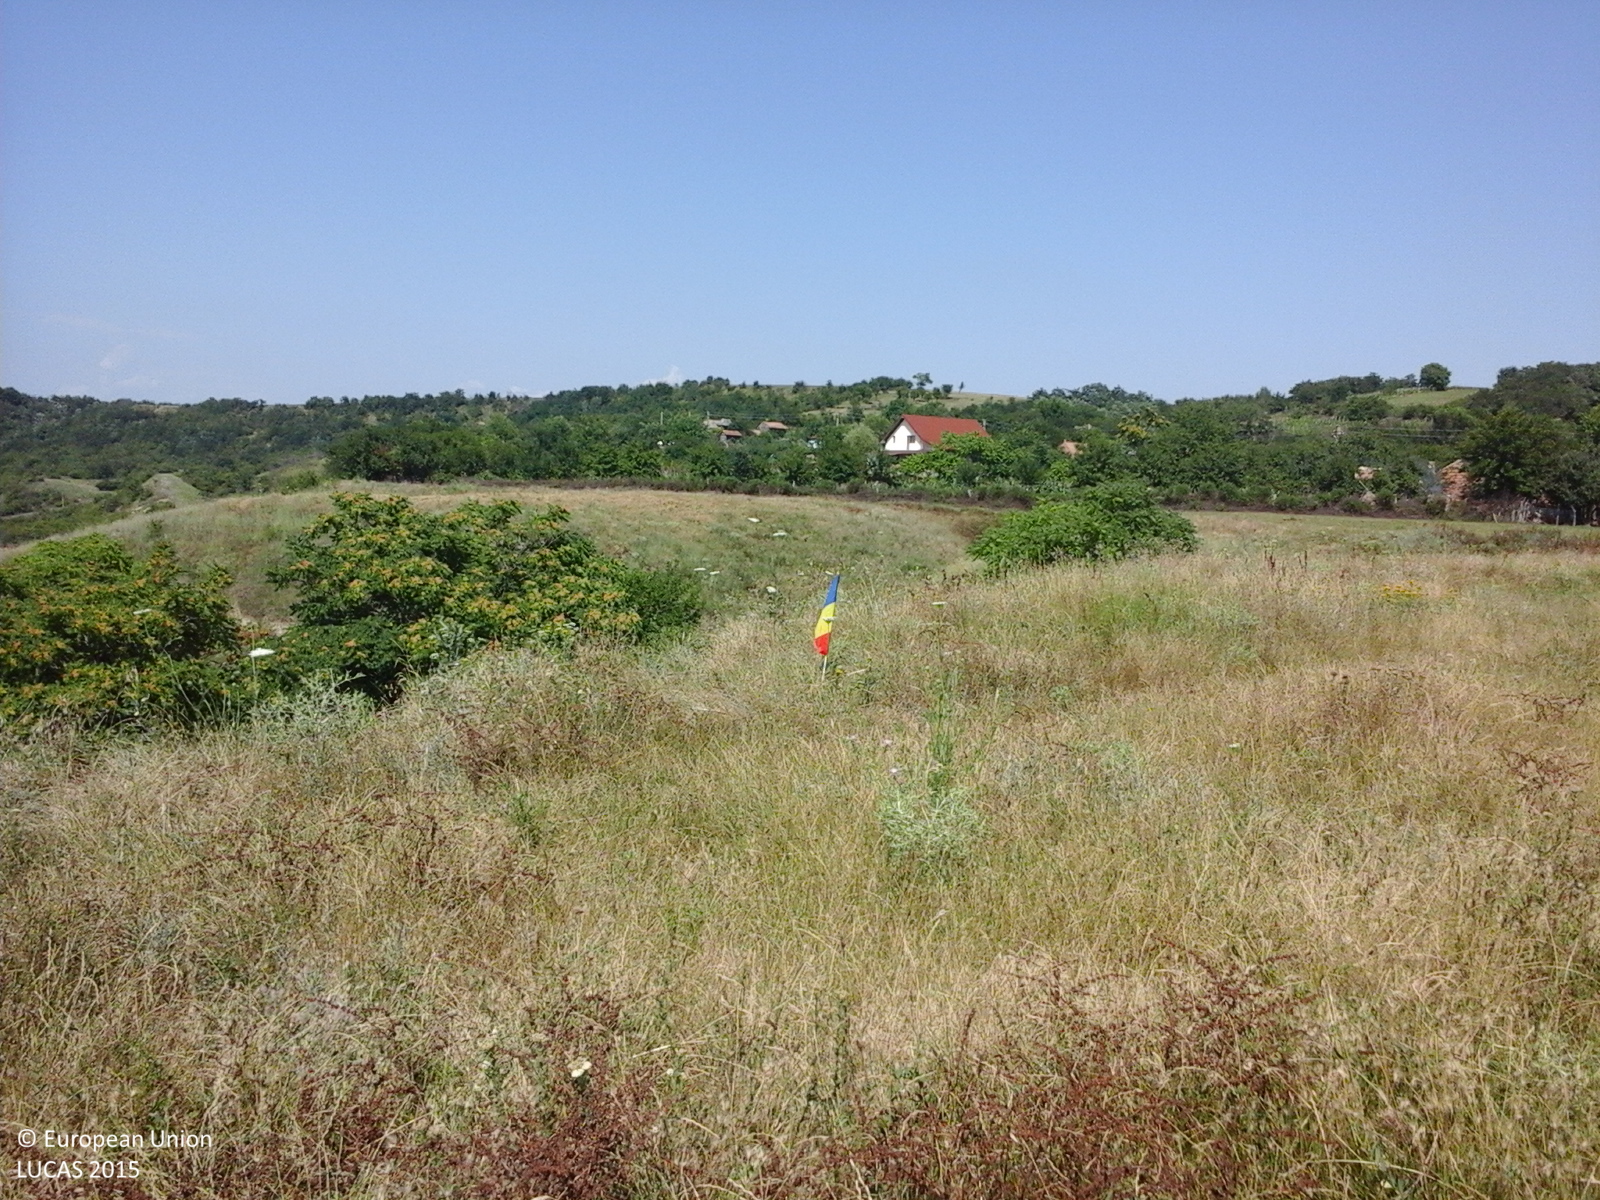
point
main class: Grassland
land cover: Grassland without tree/shrub cover
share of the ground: > 75 %
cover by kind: herbaceous plants 100 %
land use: Agriculture (excluding fallow land and kitchen gardens)
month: July
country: RO
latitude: 44.5747
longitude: 24.3366
